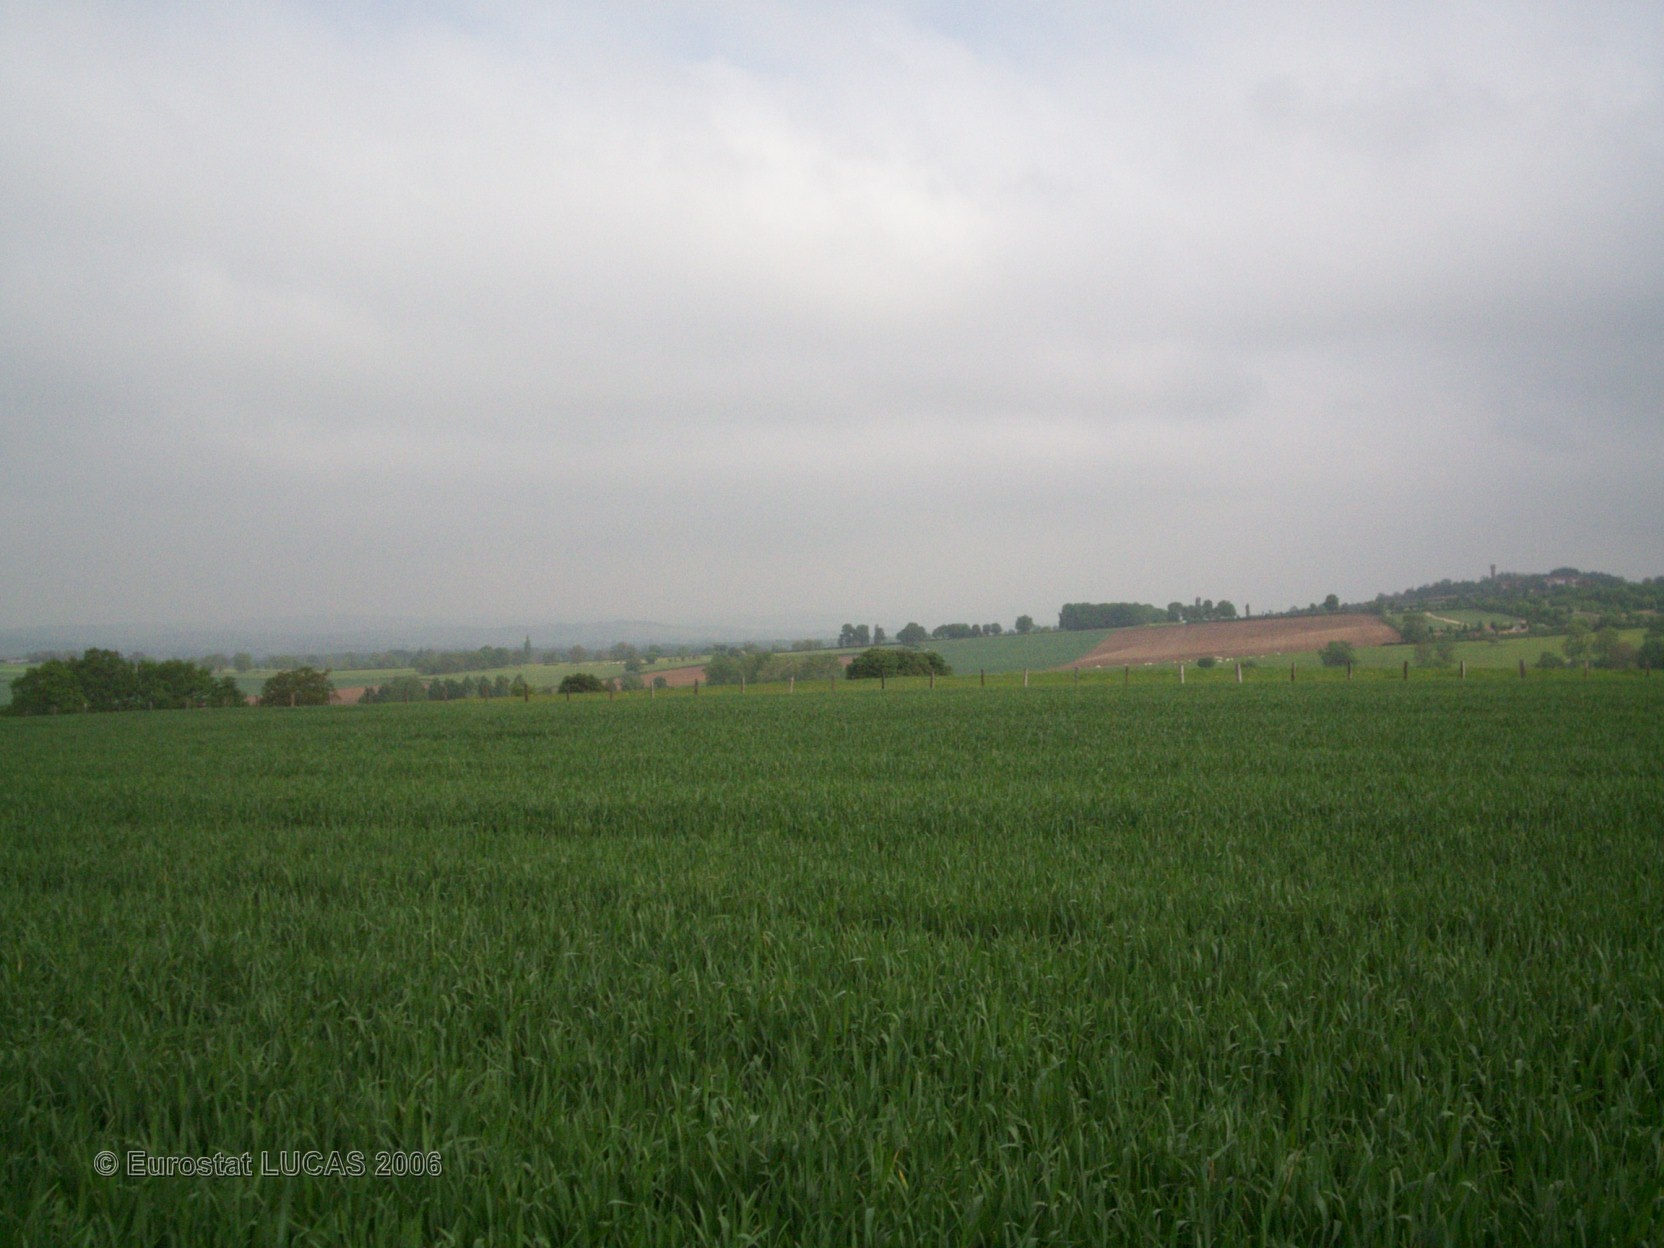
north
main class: Cropland
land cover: Common wheat
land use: Agriculture (excluding fallow land and kitchen gardens)
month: May
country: FR
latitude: 46.5072
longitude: 4.6715
